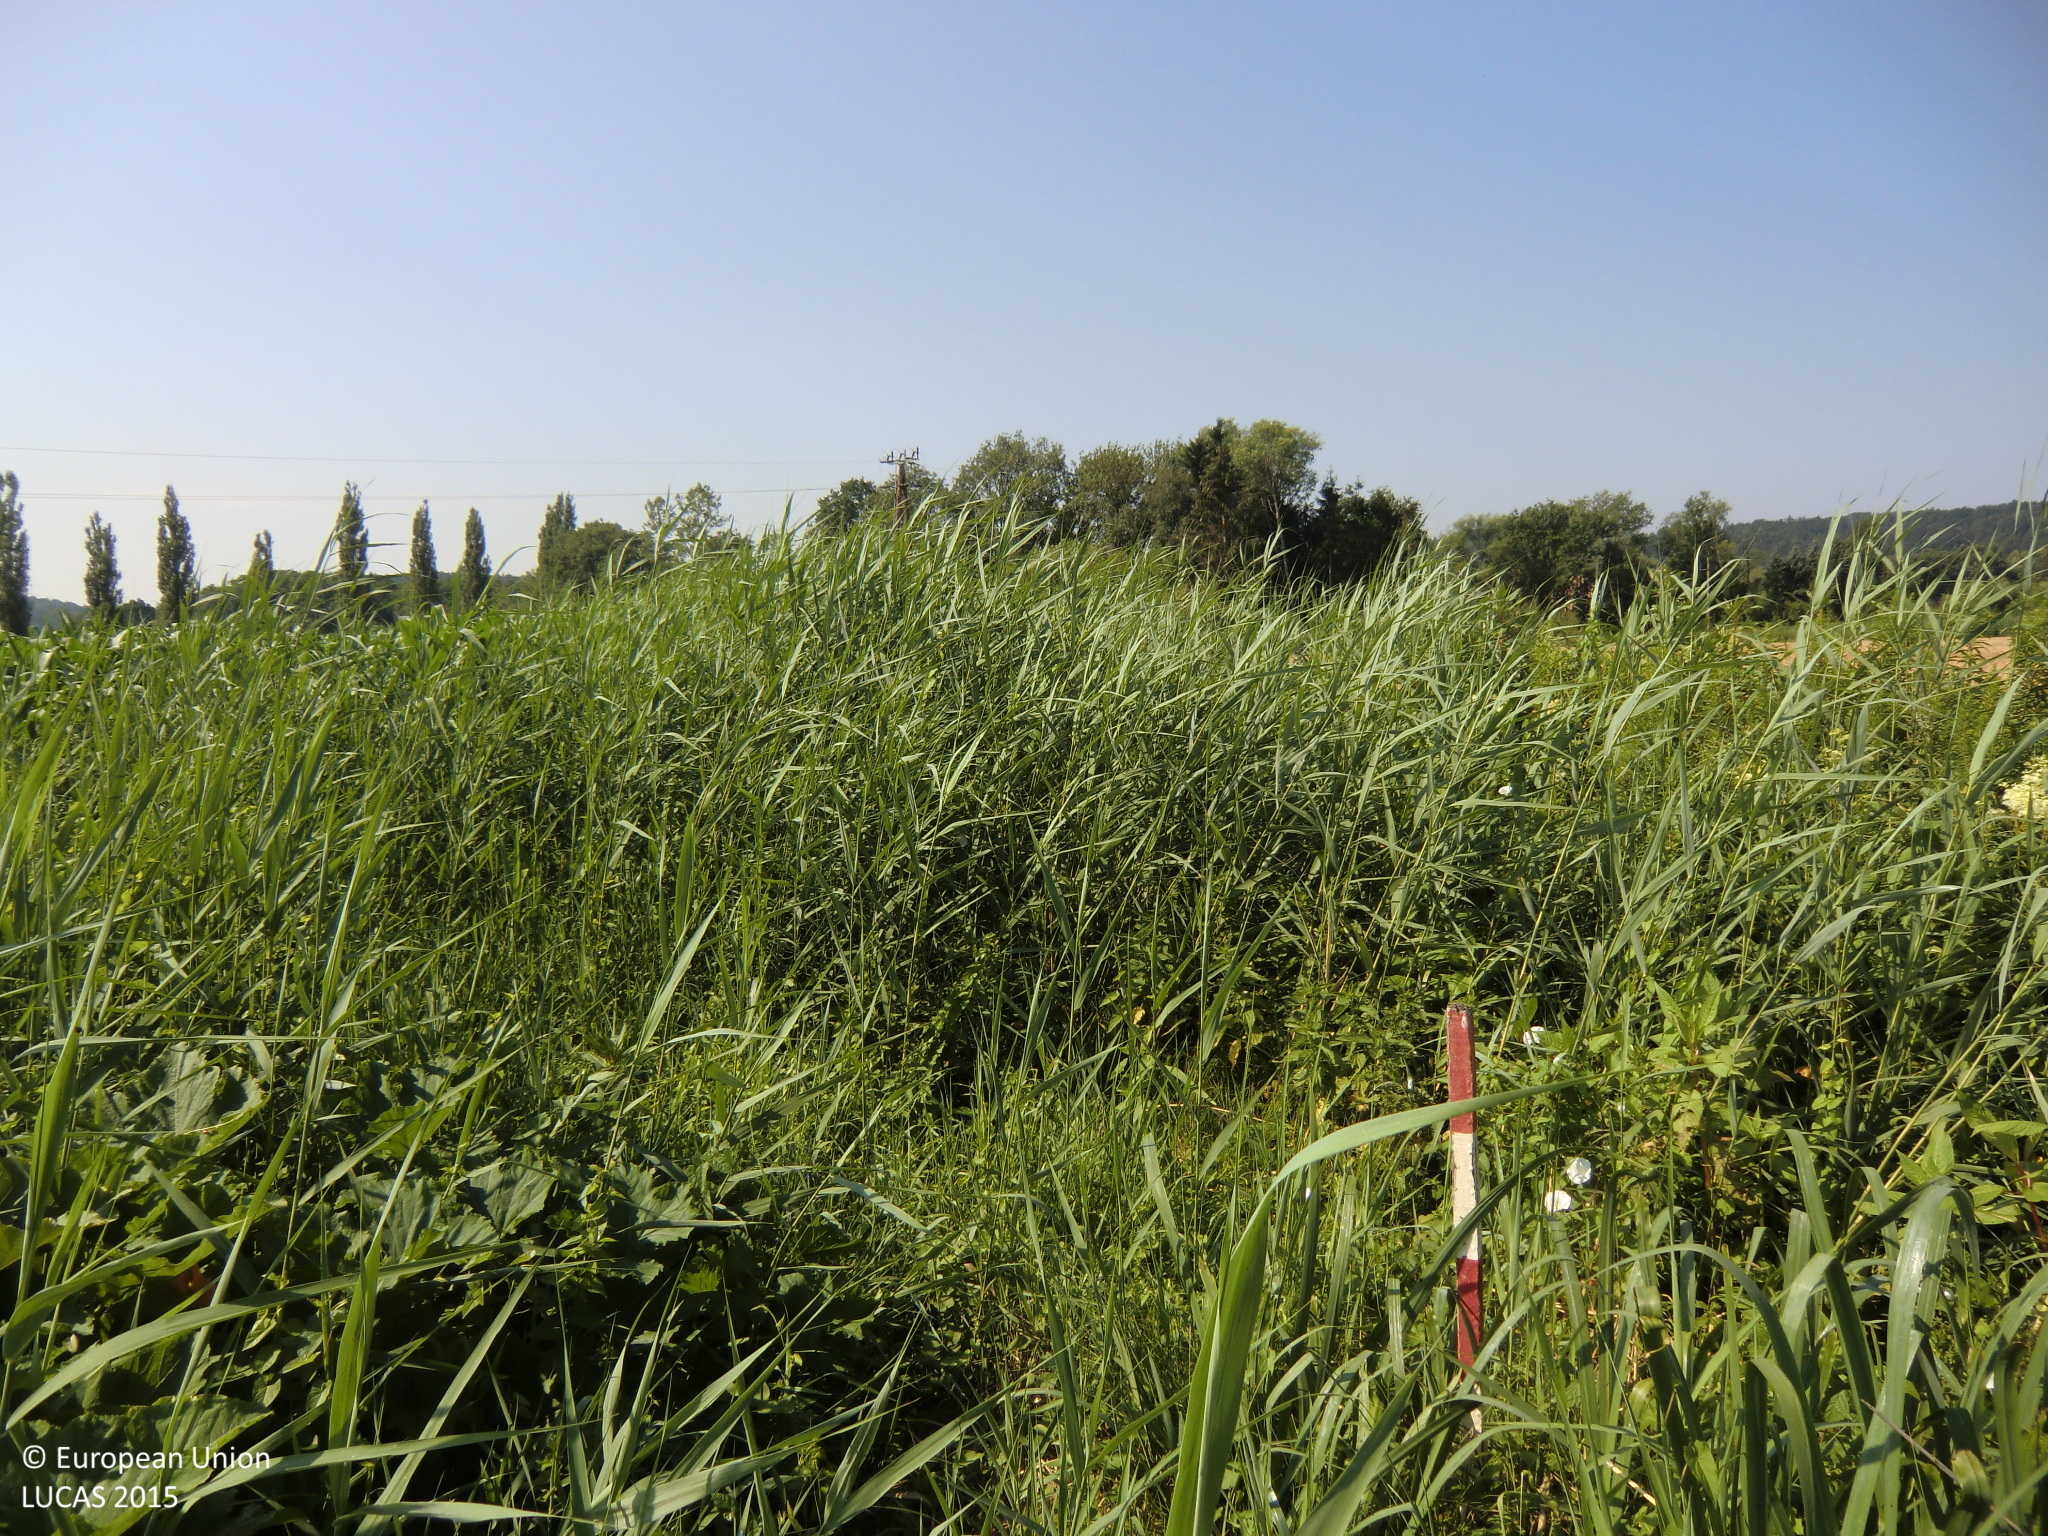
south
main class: Cropland
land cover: Other fibre and oleaginous crops
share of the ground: > 75 %
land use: Agriculture (excluding fallow land and kitchen gardens)
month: July
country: AT
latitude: 47.1261
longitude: 15.9199
